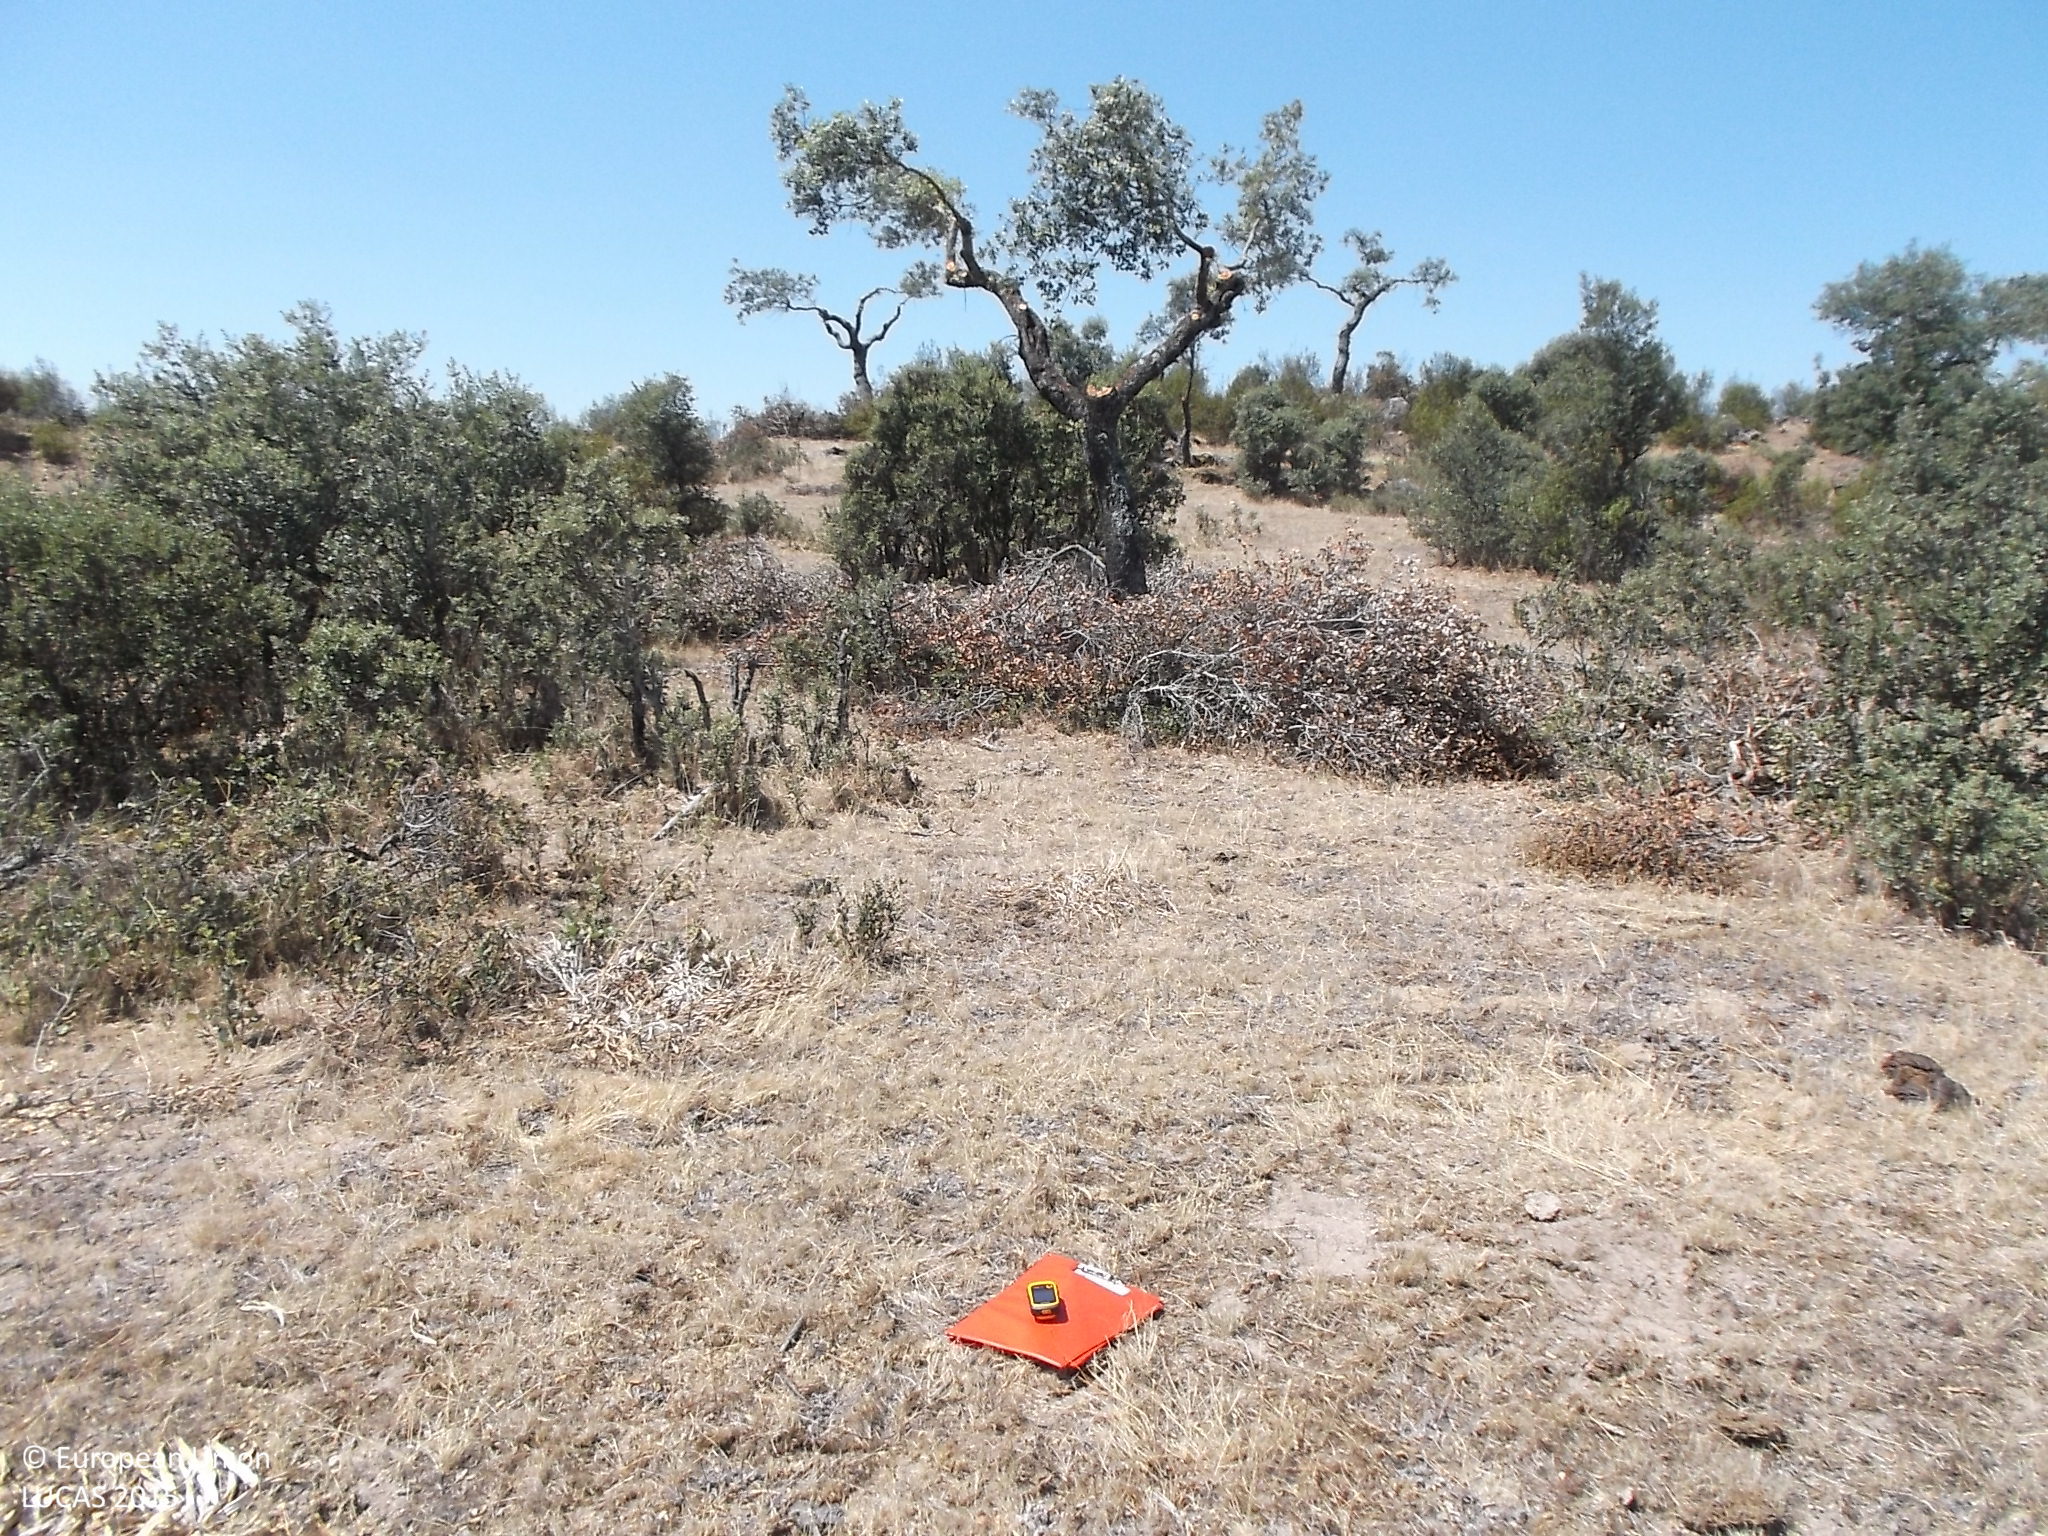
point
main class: Woodland
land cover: Broadleaved woodland
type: broadleaved evergreen forest
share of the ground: 10 - 25 %
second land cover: Grassland without tree/shrub cover
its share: > 75 %
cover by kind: herbaceous plants 80 %, broadleaved forest trees 20 %
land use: Forestry
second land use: Agriculture (excluding fallow land and kitchen gardens)
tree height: < 5 m
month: July
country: ES
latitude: 41.3456
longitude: -5.8255
